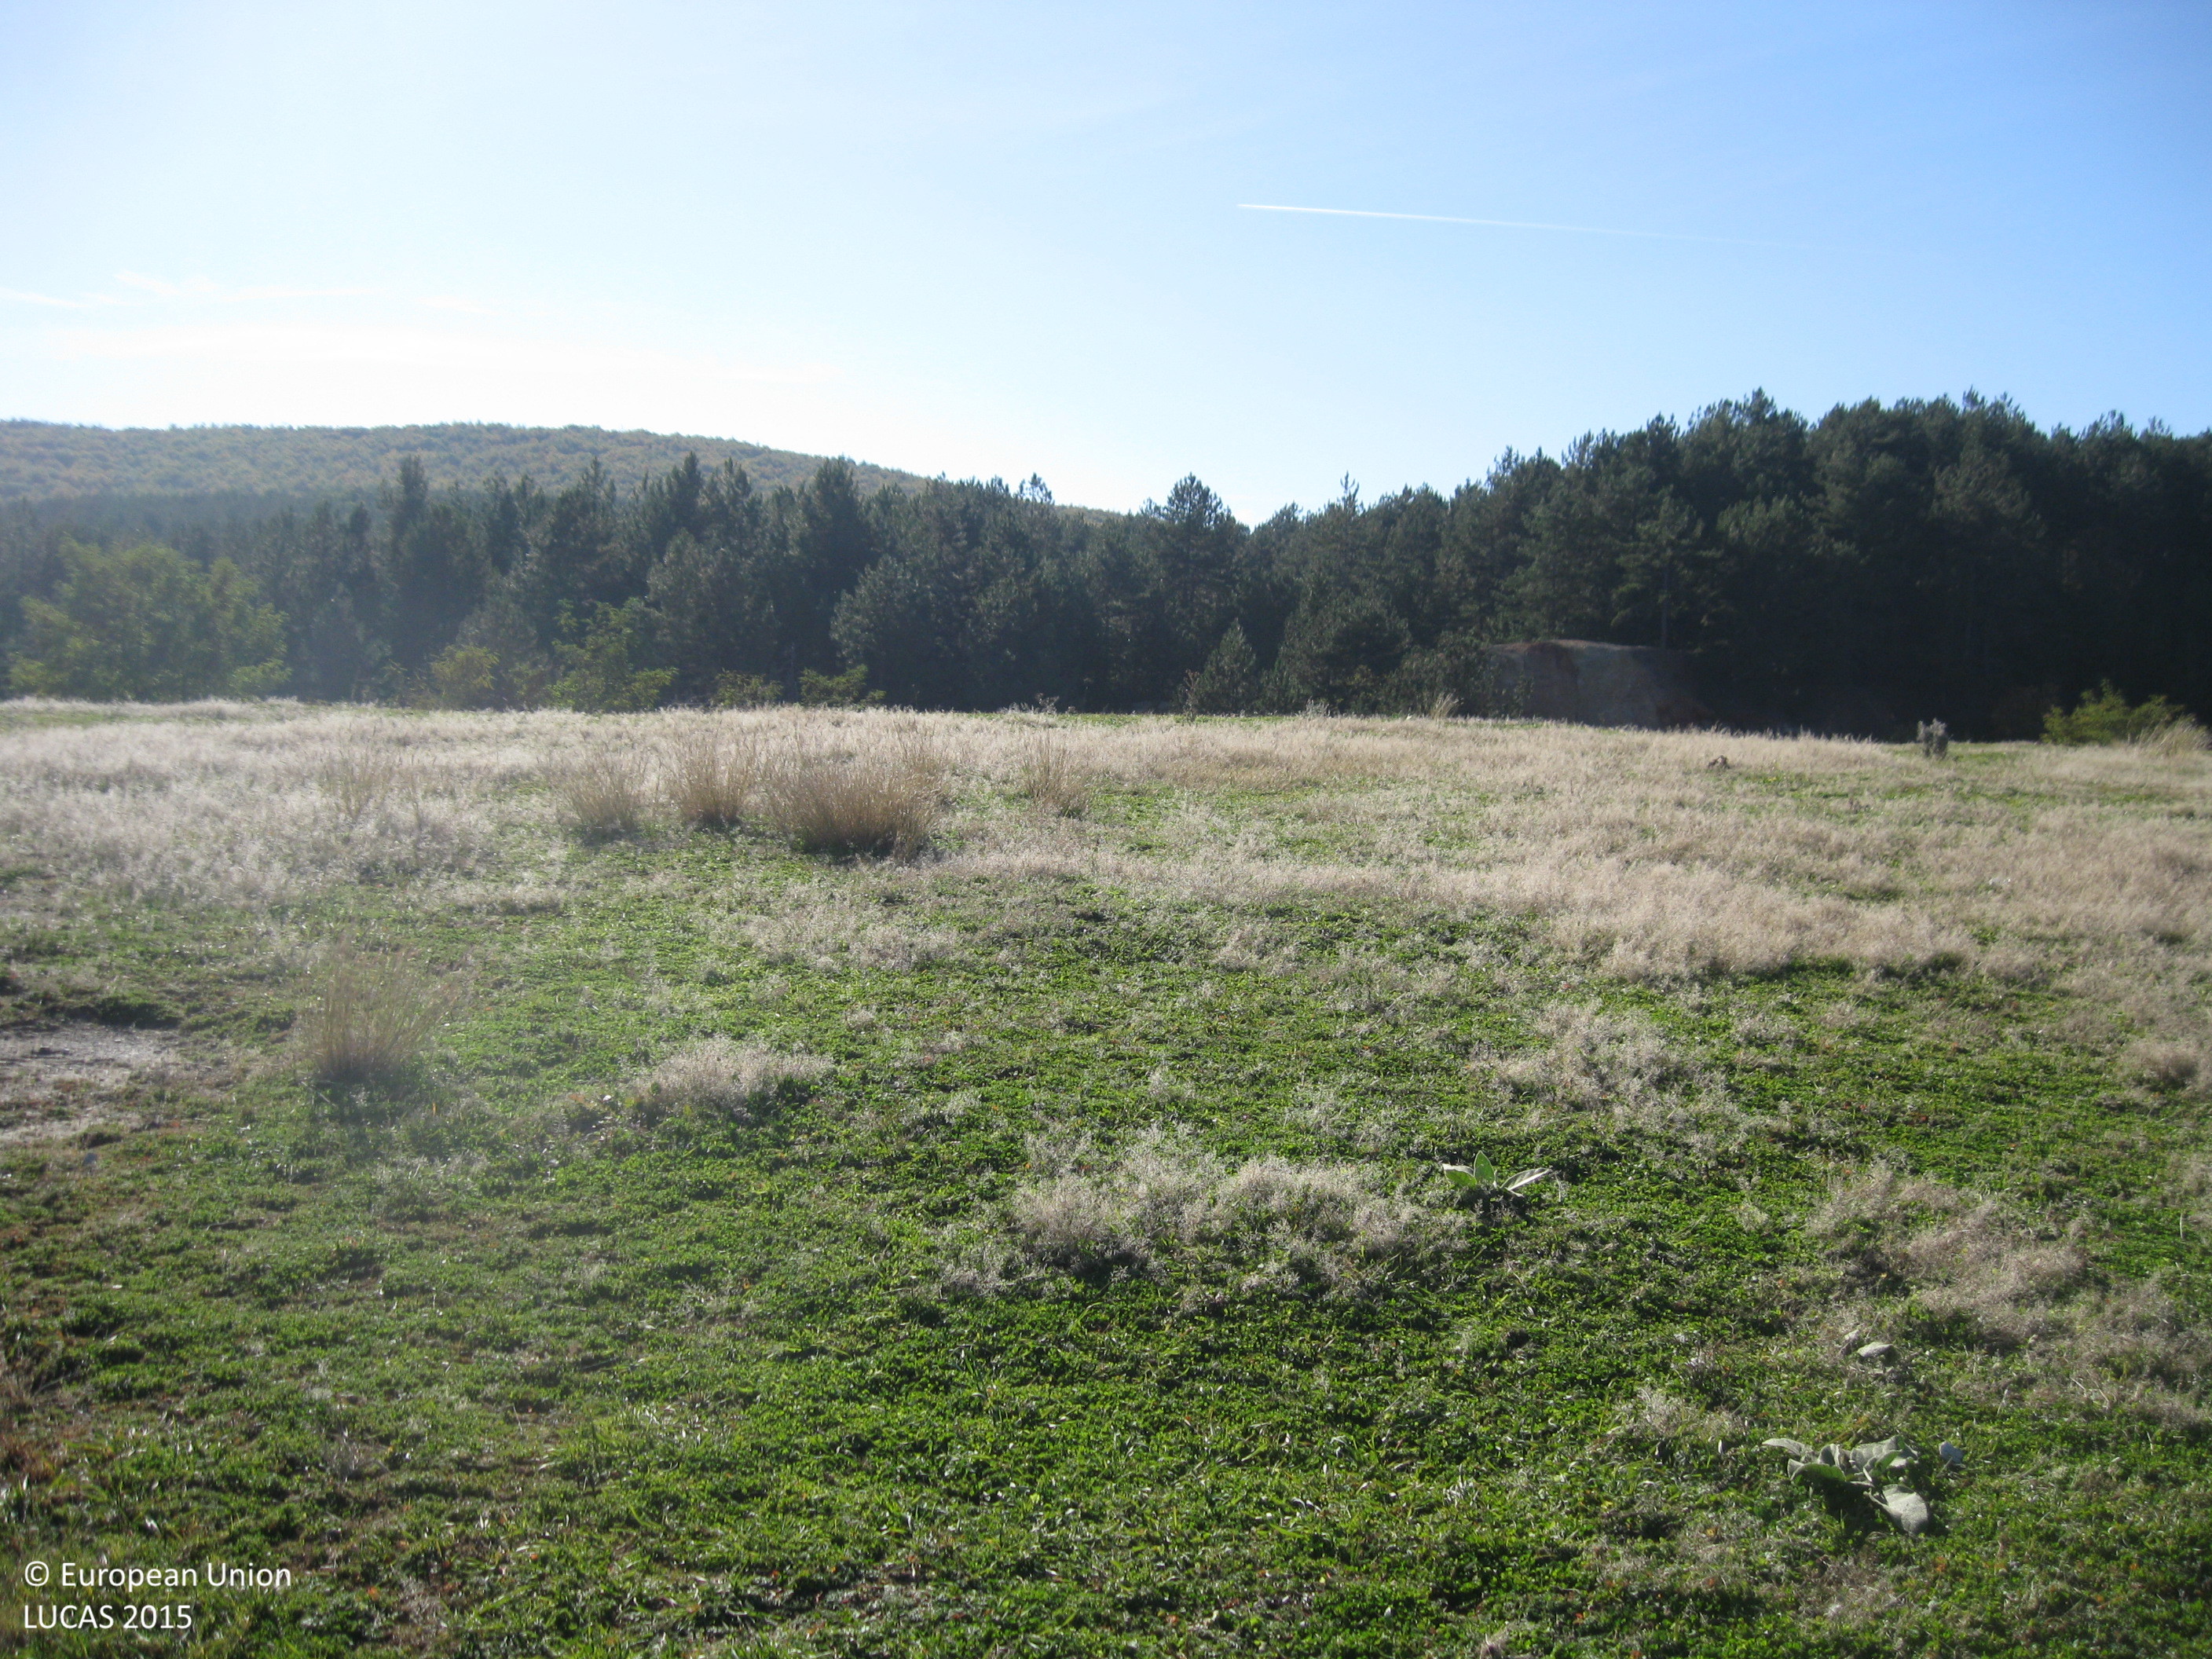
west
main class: Grassland
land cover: Grassland without tree/shrub cover
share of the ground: > 75 %
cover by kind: herbaceous plants 100 %
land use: Semi-natural and natural areas not in use
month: November
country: BG
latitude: 42.3599
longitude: 24.2137
